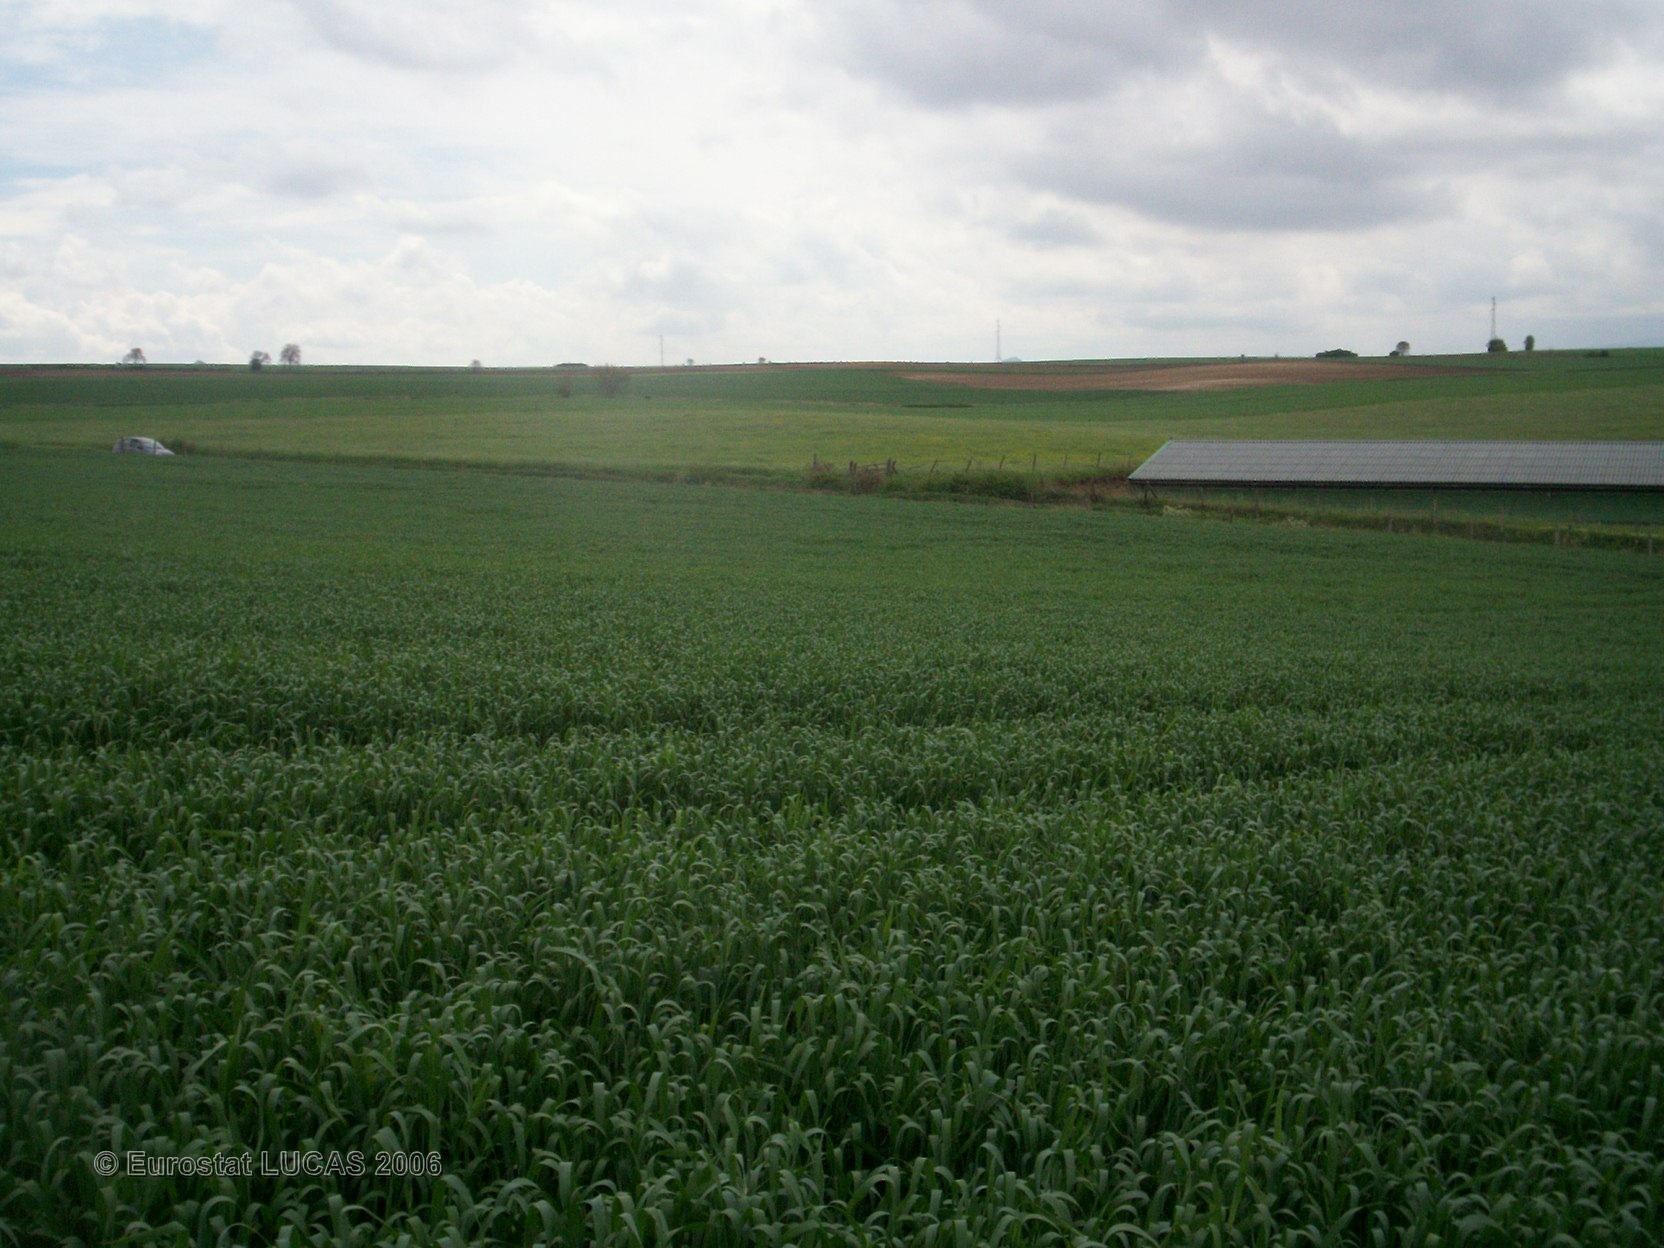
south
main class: Cropland
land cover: Common wheat
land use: Agriculture (excluding fallow land and kitchen gardens)
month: May
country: FR
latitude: 45.6279
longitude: 3.1895
